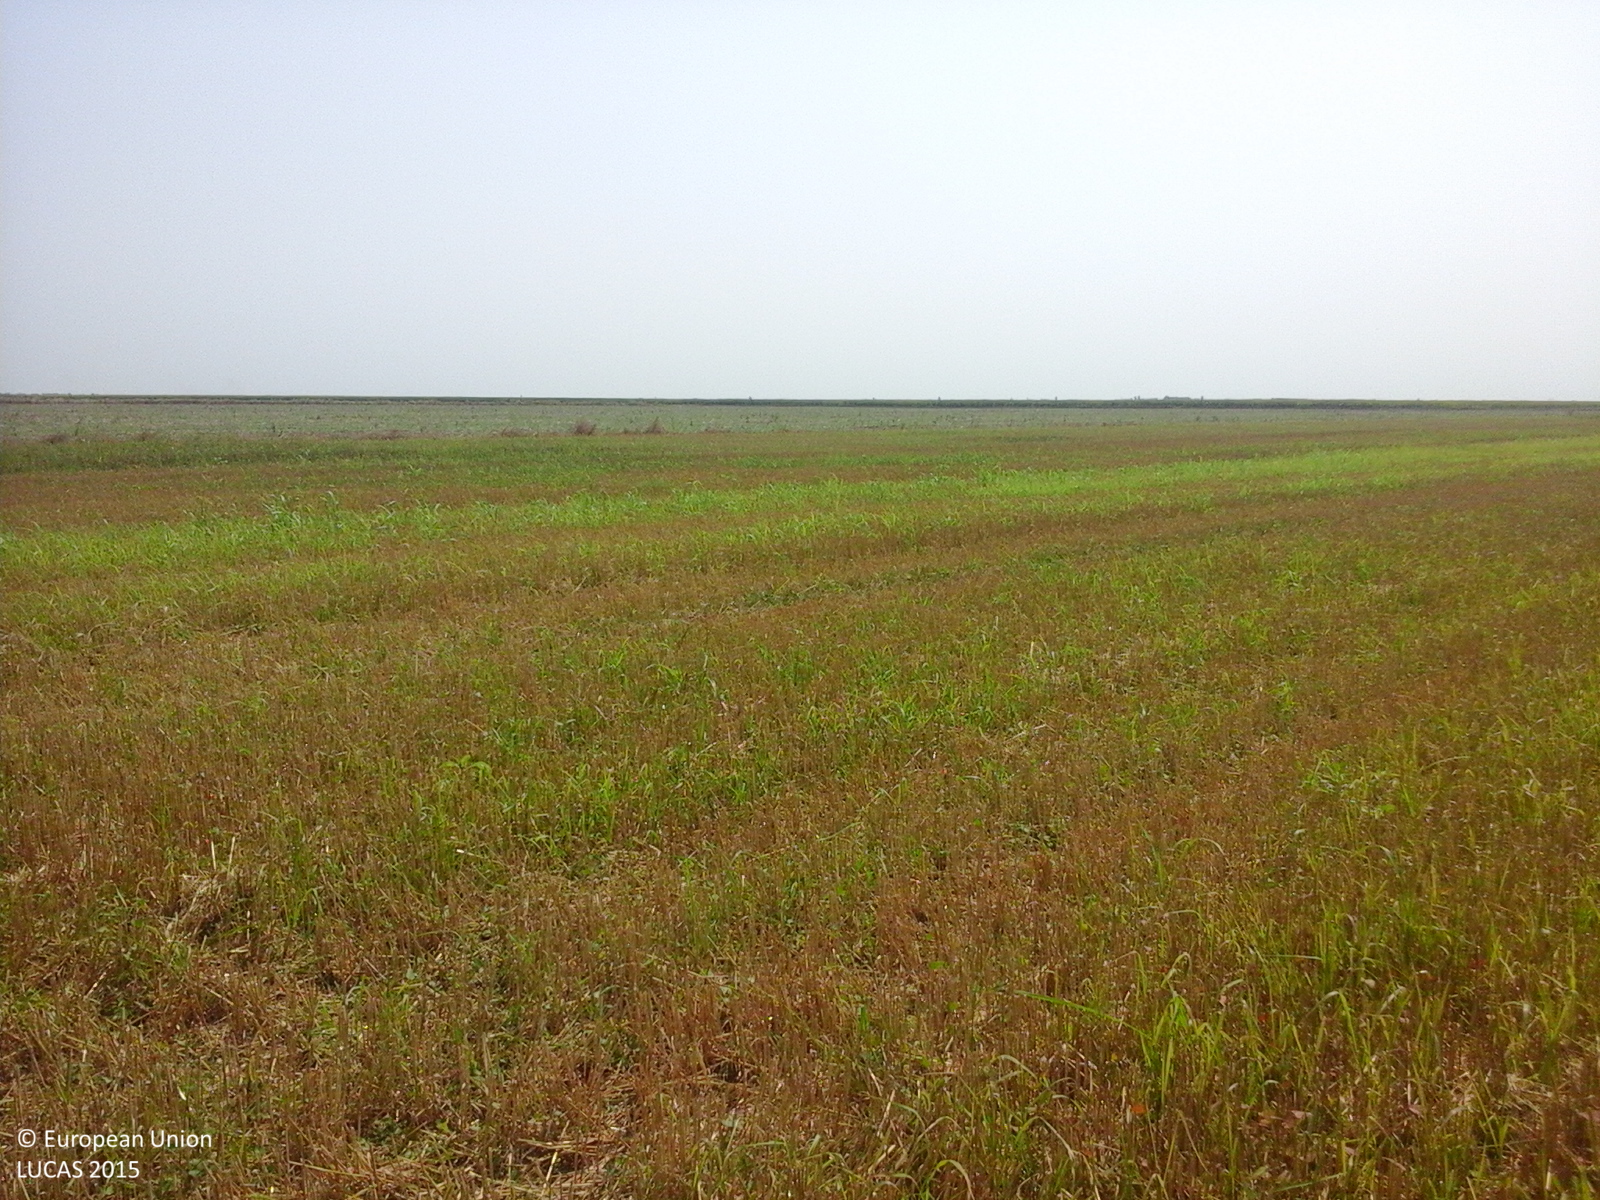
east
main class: Cropland
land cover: Common wheat
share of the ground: 50 - 75 %
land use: Agriculture (excluding fallow land and kitchen gardens)
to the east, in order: Common wheat; Rape and turnip rape
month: July
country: RO
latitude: 44.7653
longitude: 26.6091
